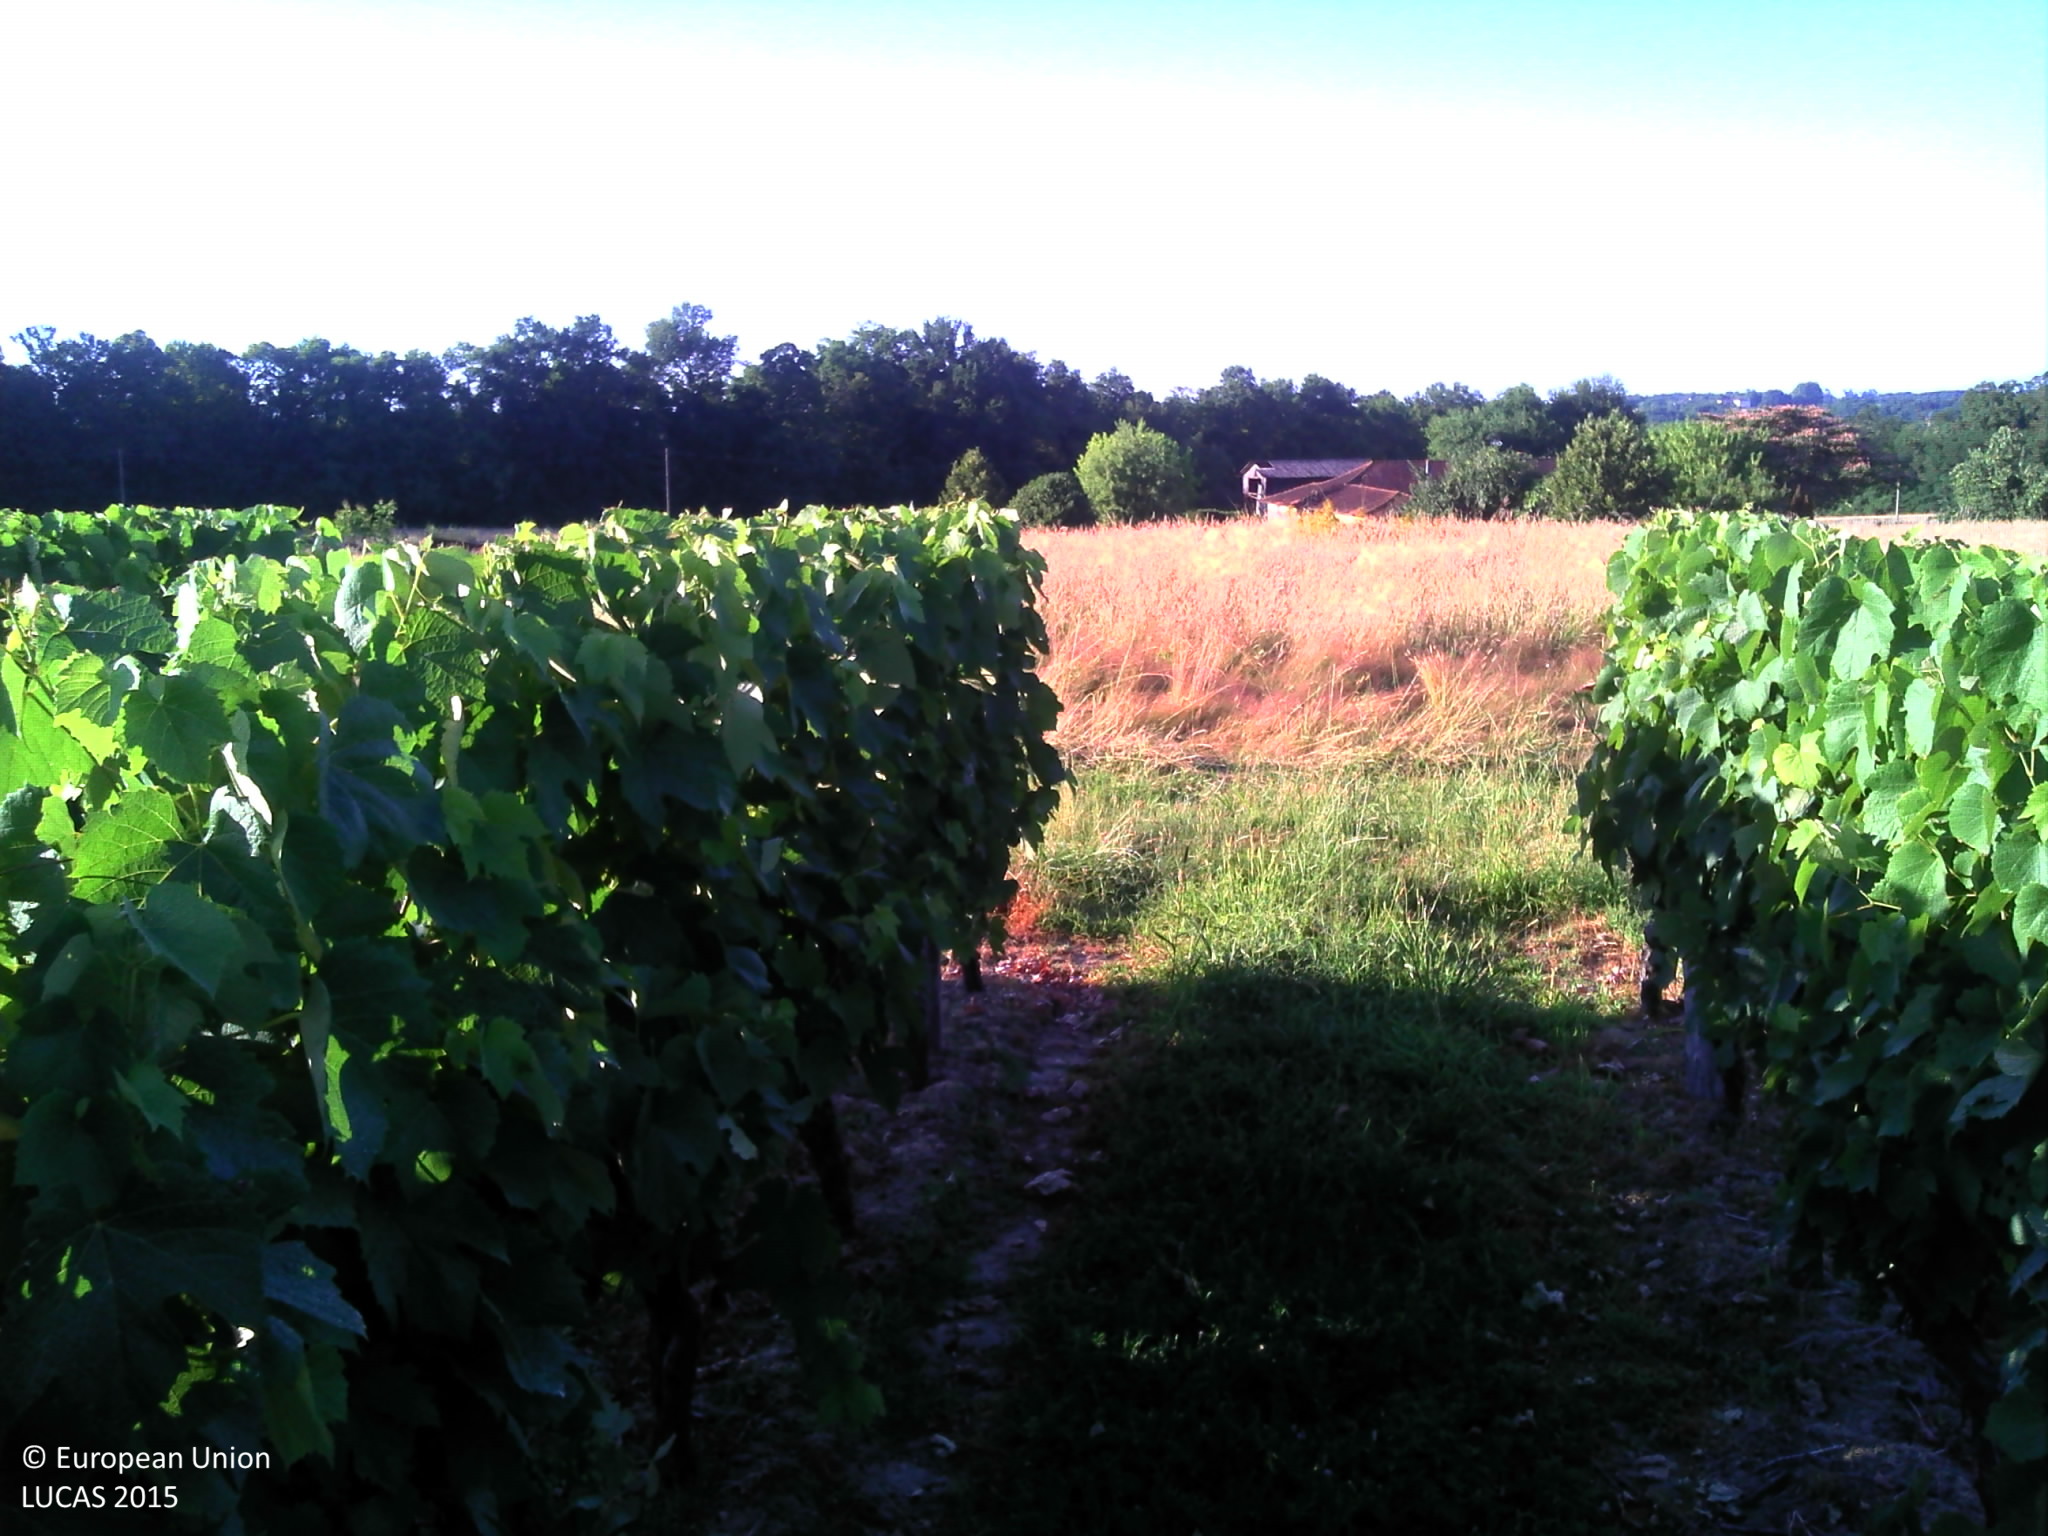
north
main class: Cropland
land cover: Vineyards
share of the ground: 25 - 50 %
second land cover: Grassland without tree/shrub cover
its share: 25 - 50 %
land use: Agriculture (excluding fallow land and kitchen gardens)
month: July
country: FR
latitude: 43.8957
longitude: -0.2555
